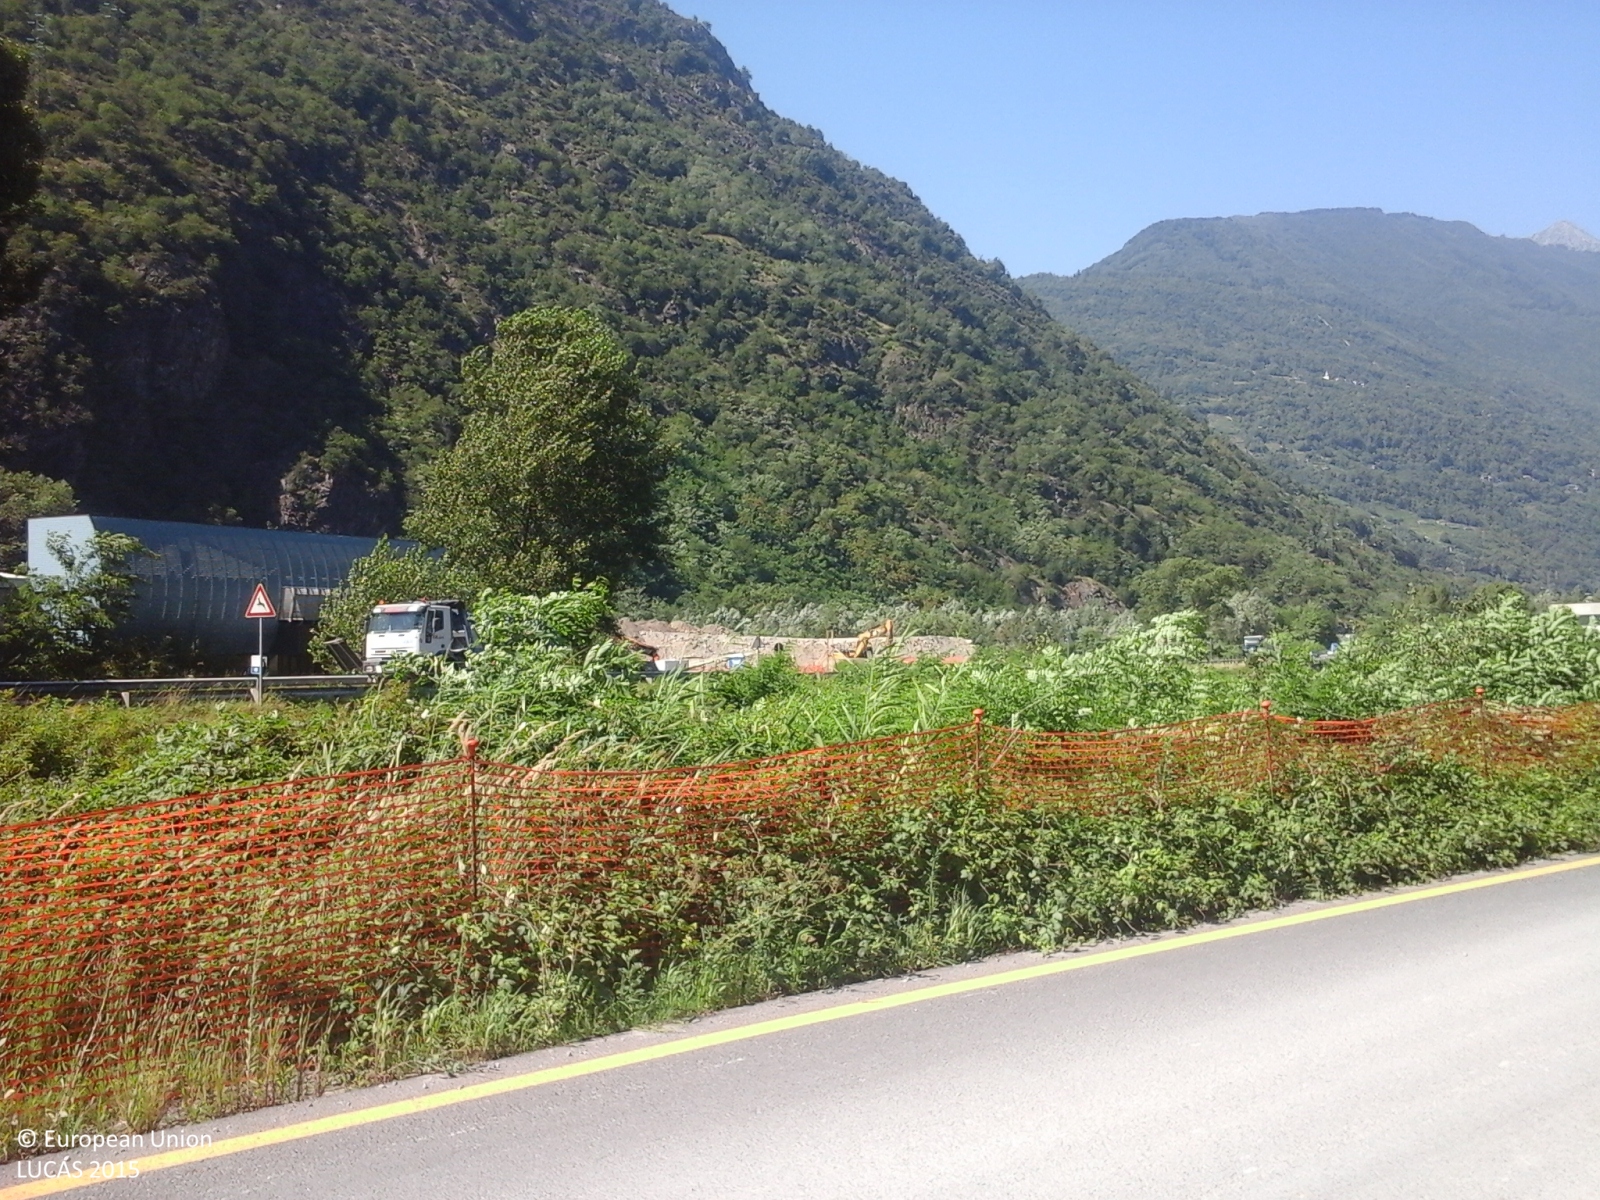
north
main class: Woodland
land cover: Broadleaved woodland
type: thermophilous deciduous forest
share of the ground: > 75 %
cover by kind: broadleaved forest trees 100 %
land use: Forestry
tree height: > 5 m
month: August
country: IT
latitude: 46.1524
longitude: 9.6250
